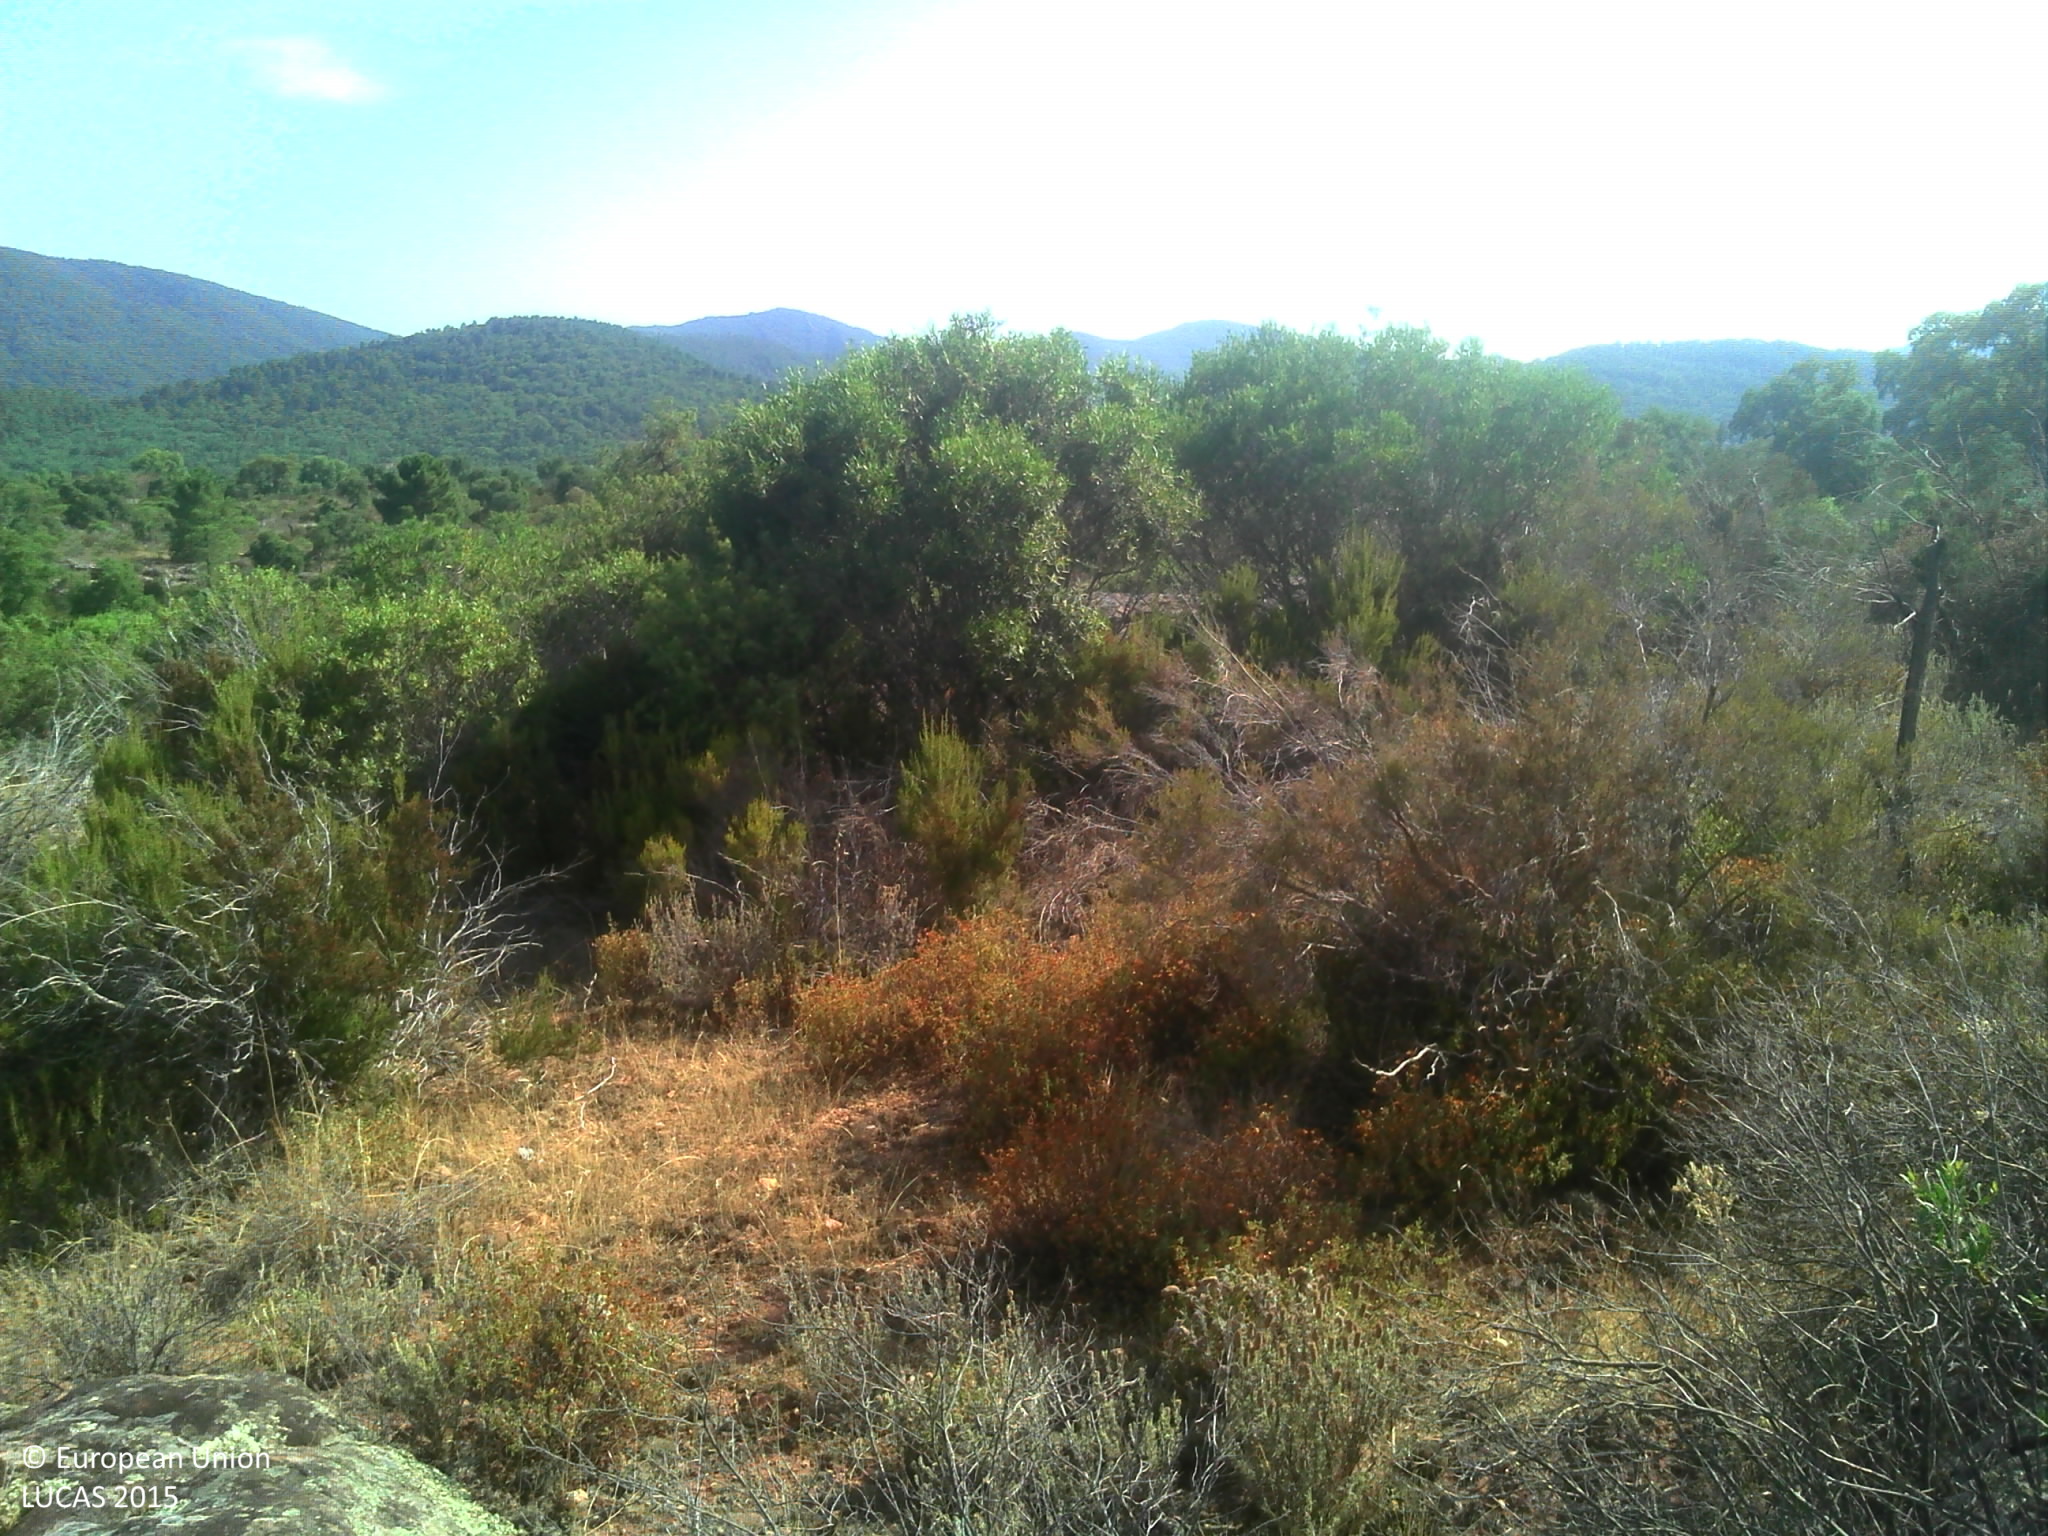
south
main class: Shrubland
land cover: Shrubland without tree cover
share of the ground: > 75 %
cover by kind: shrubs 100 %
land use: Semi-natural and natural areas not in use
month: July
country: FR
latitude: 43.3300
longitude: 6.3709
